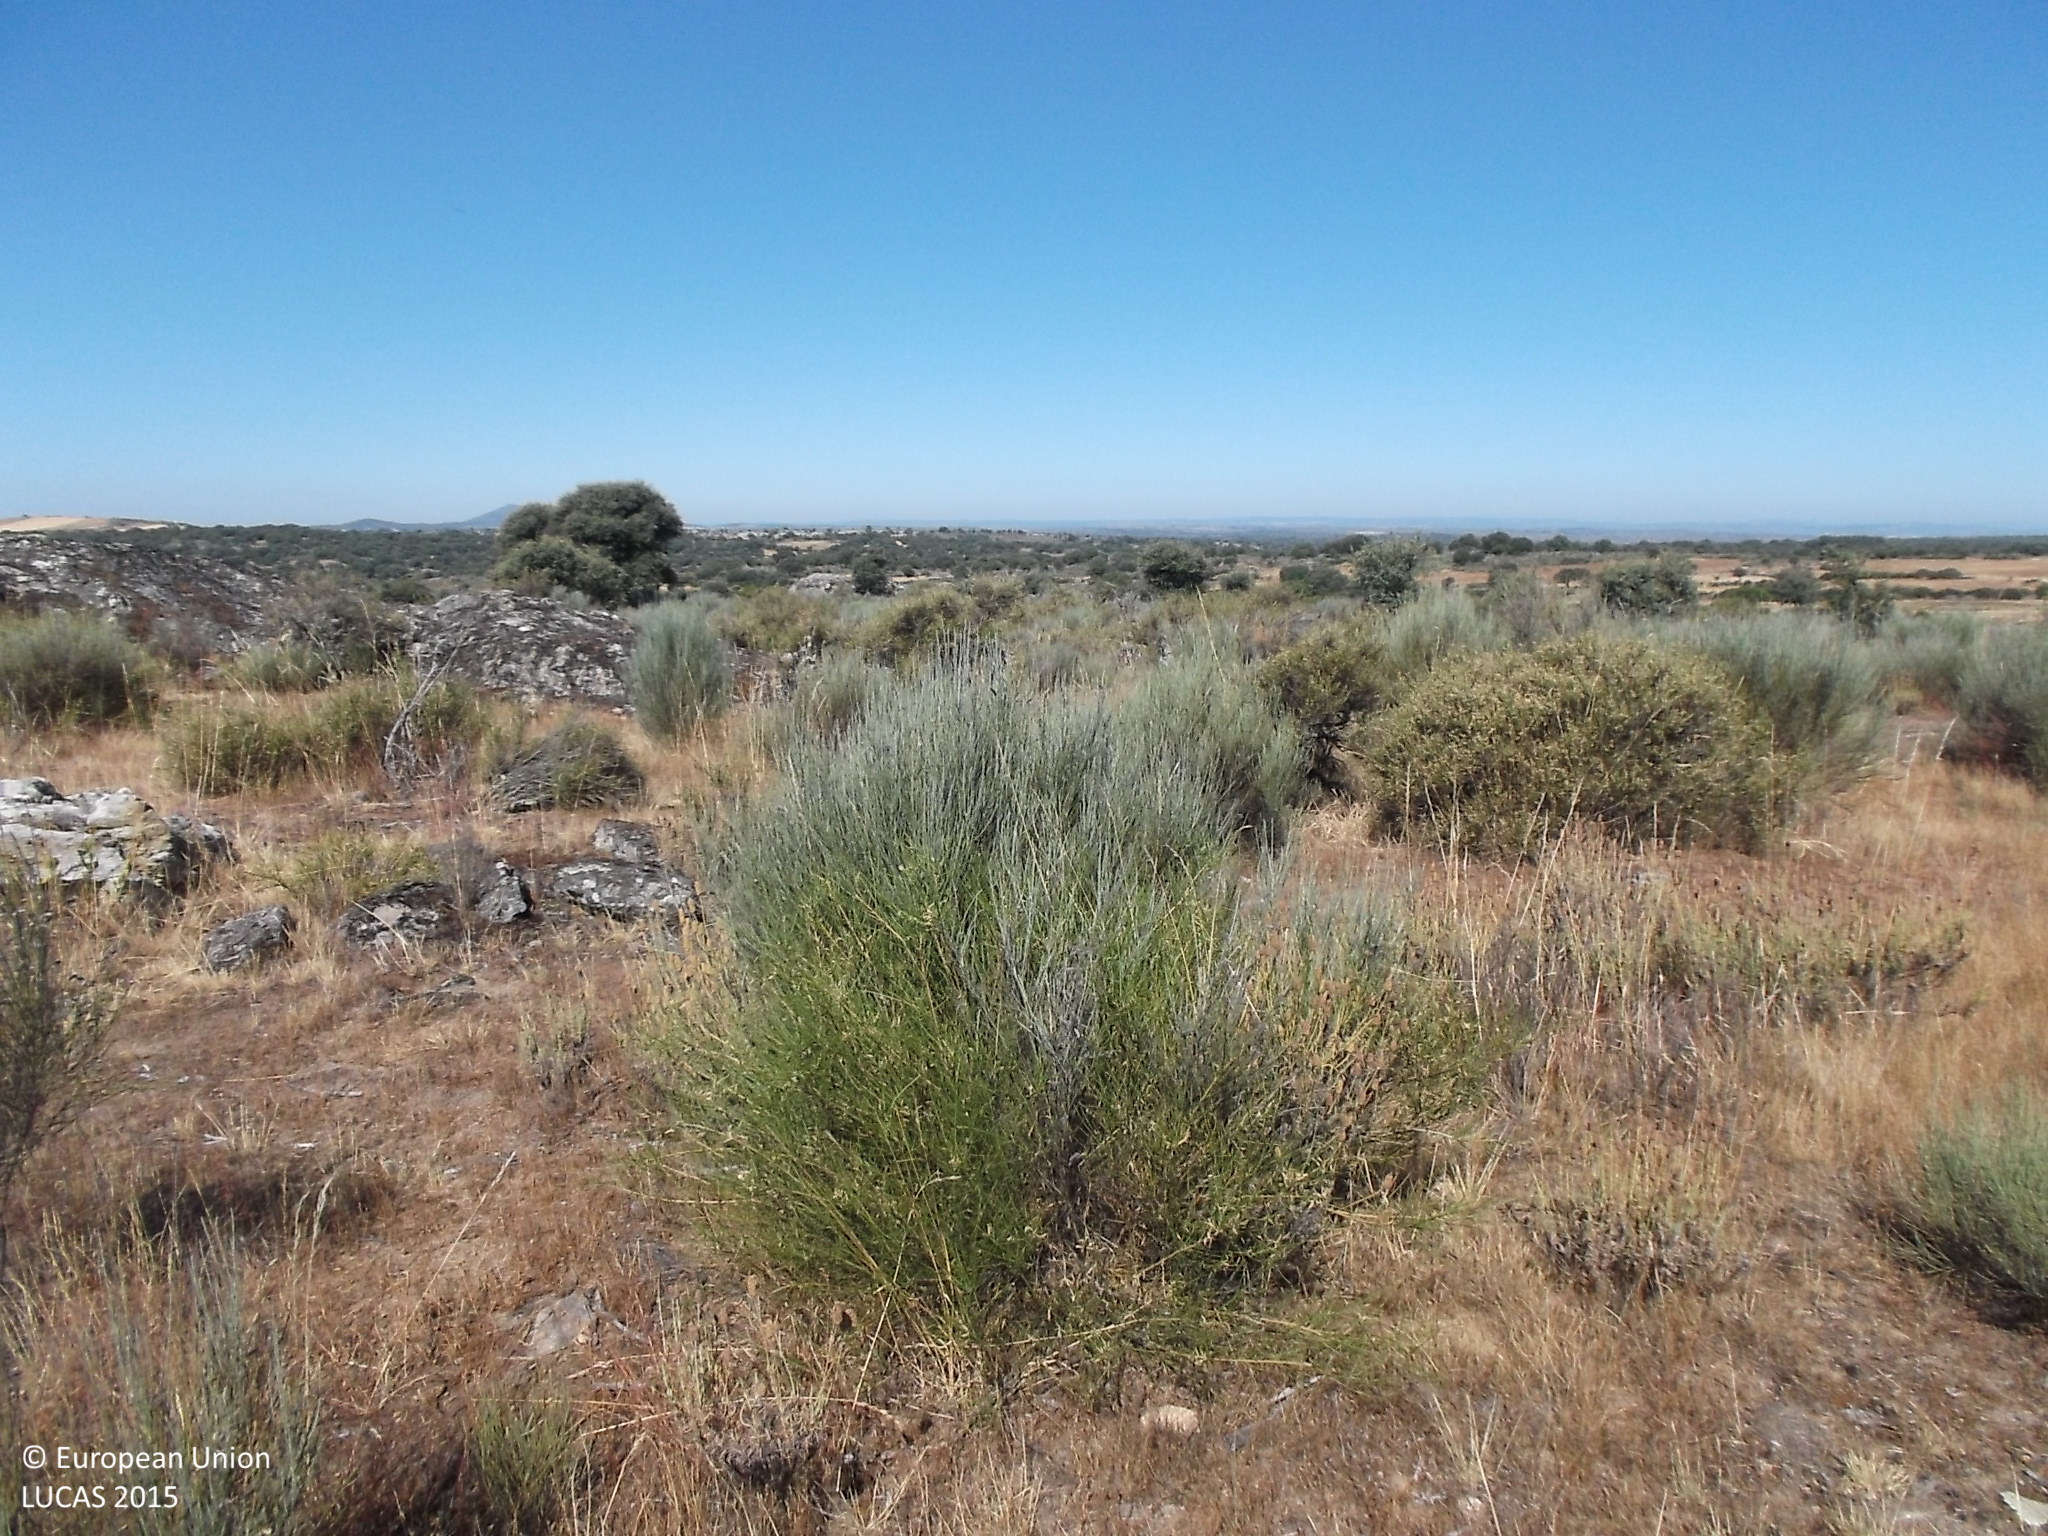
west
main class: Shrubland
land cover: Shrubland without tree cover
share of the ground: > 75 %
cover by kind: shrubs 70 %, herbaceous plants 30 %
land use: Agriculture (excluding fallow land and kitchen gardens)
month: June
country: ES
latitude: 40.9323
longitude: -6.7627
